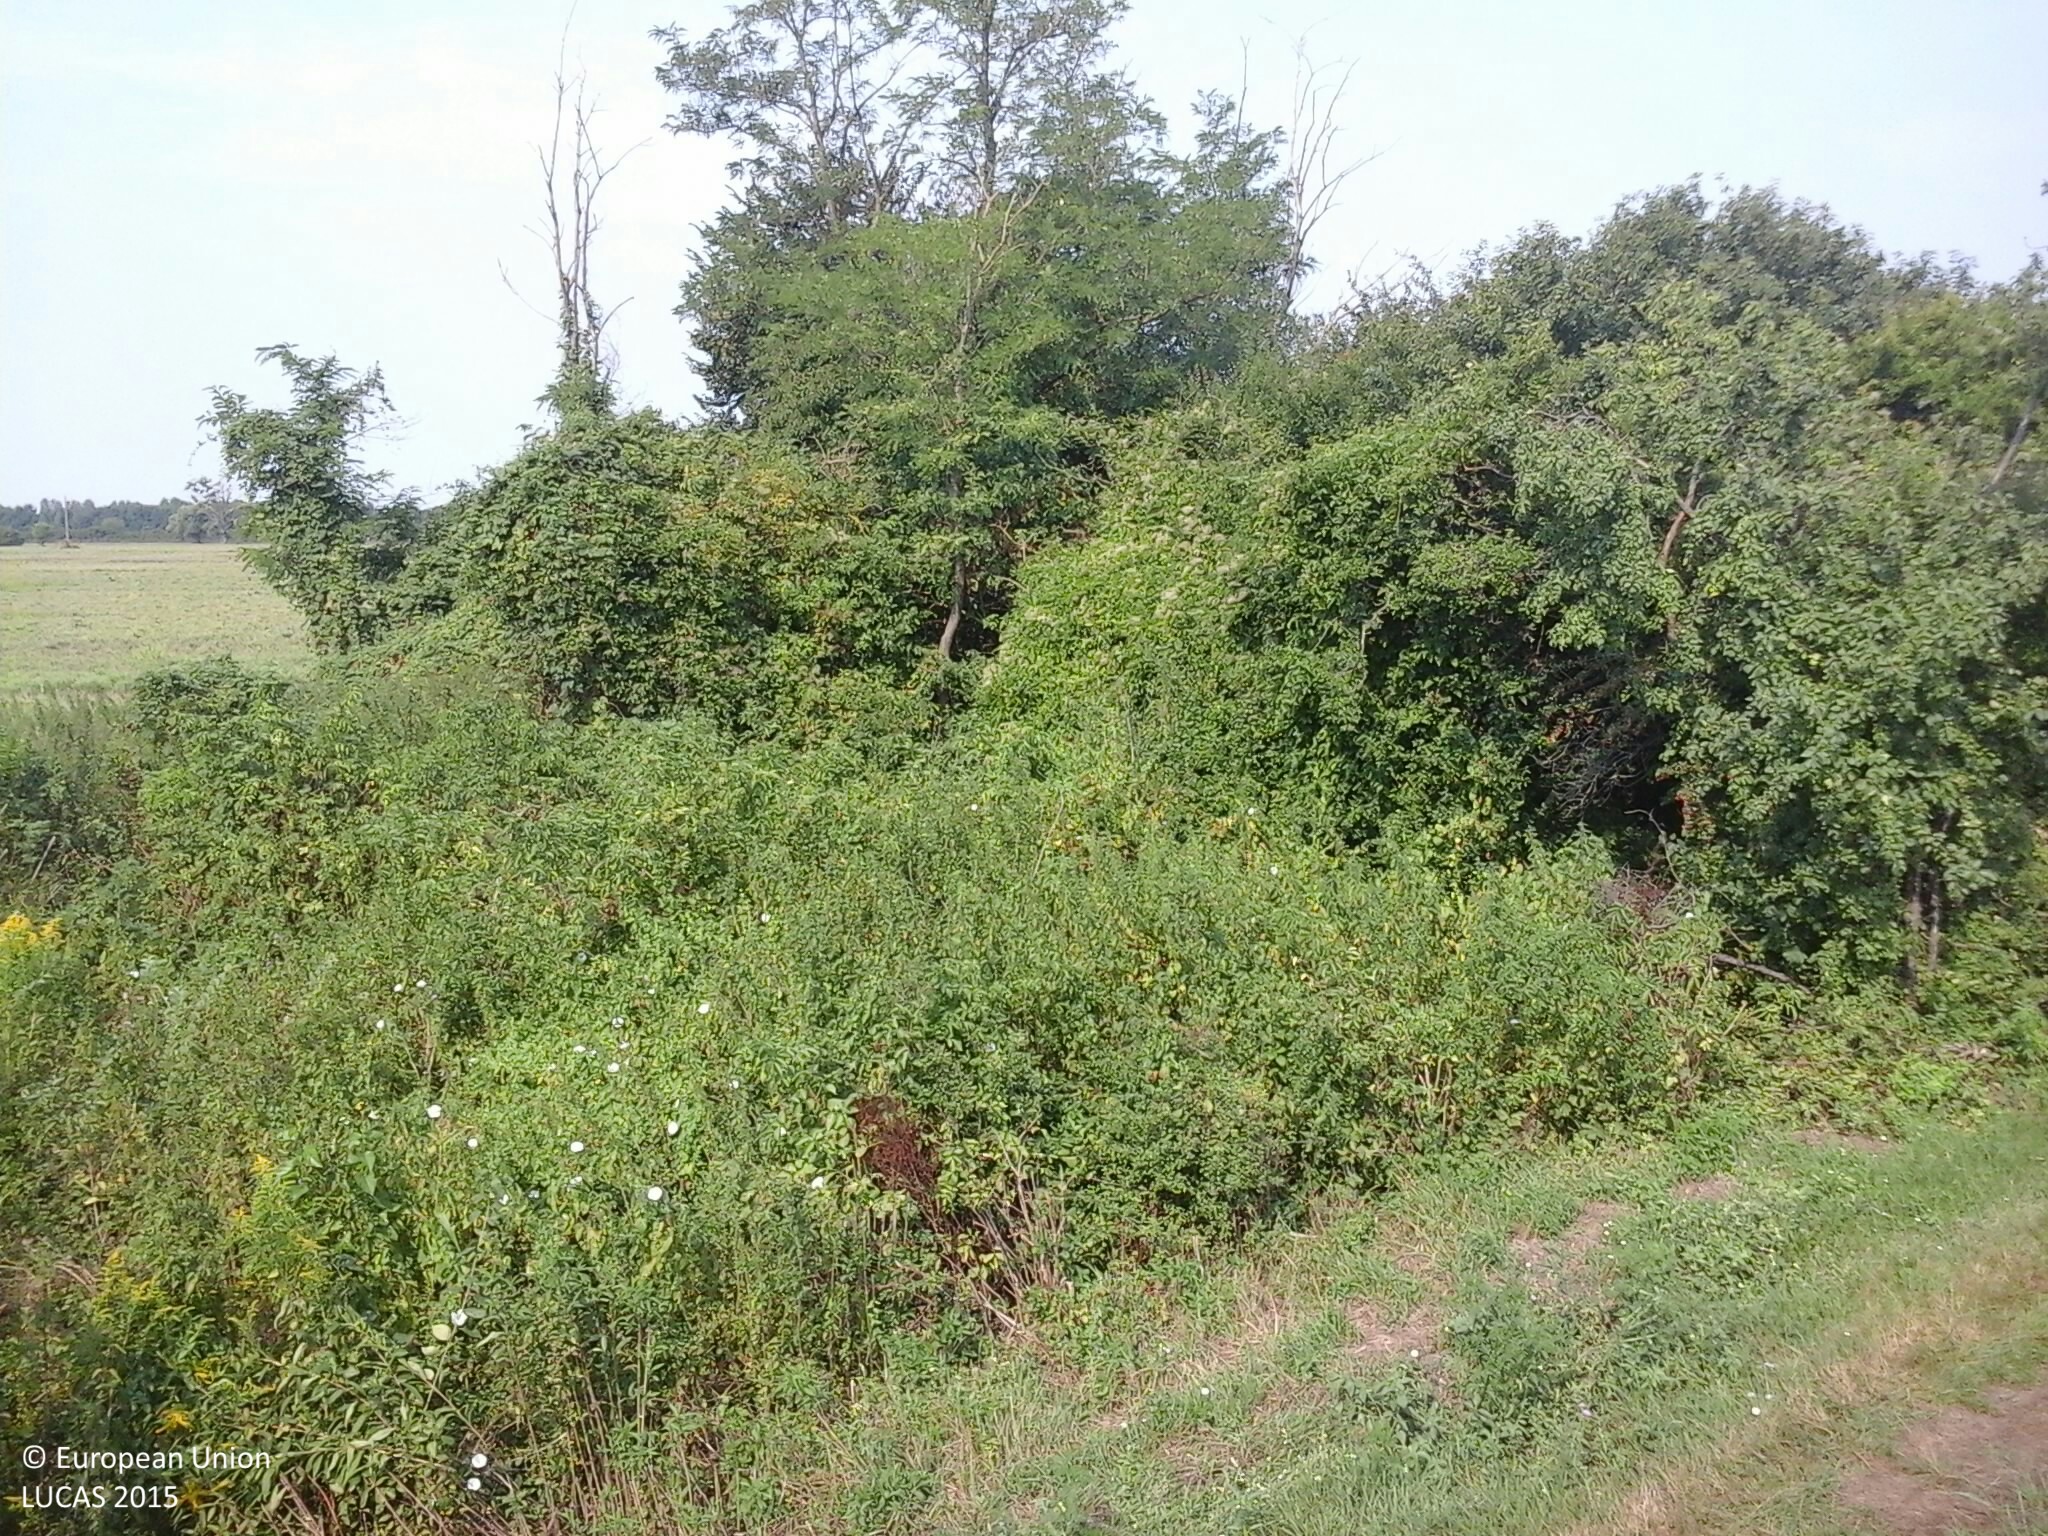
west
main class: Artificial land
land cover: Other artificial areas
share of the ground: < 10 %
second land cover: Maize
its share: > 75 %
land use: Electricity, gas and thermal power distribution
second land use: Agriculture (excluding fallow land and kitchen gardens)
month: August
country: HU
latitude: 46.0430
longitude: 18.1087
